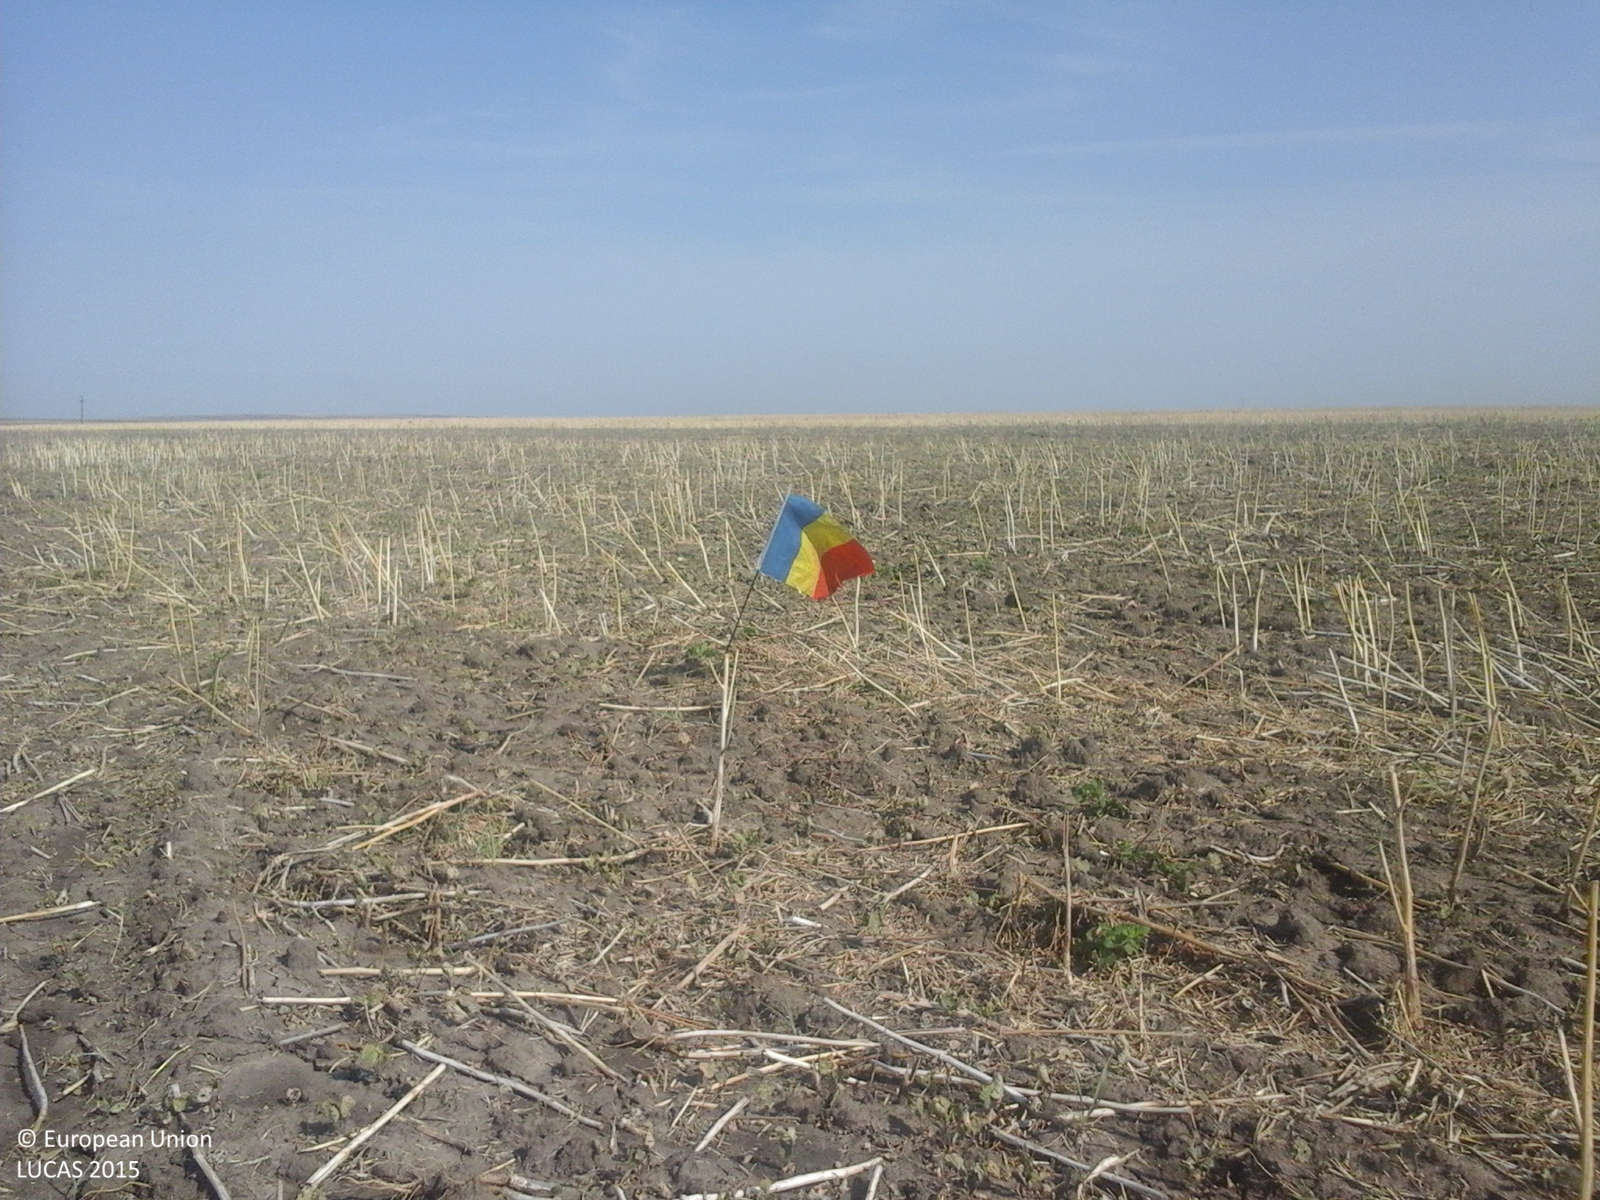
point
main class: Cropland
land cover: Rape and turnip rape
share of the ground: 10 - 25 %
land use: Agriculture (excluding fallow land and kitchen gardens)
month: August
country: RO
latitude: 44.2308
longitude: 23.0773
